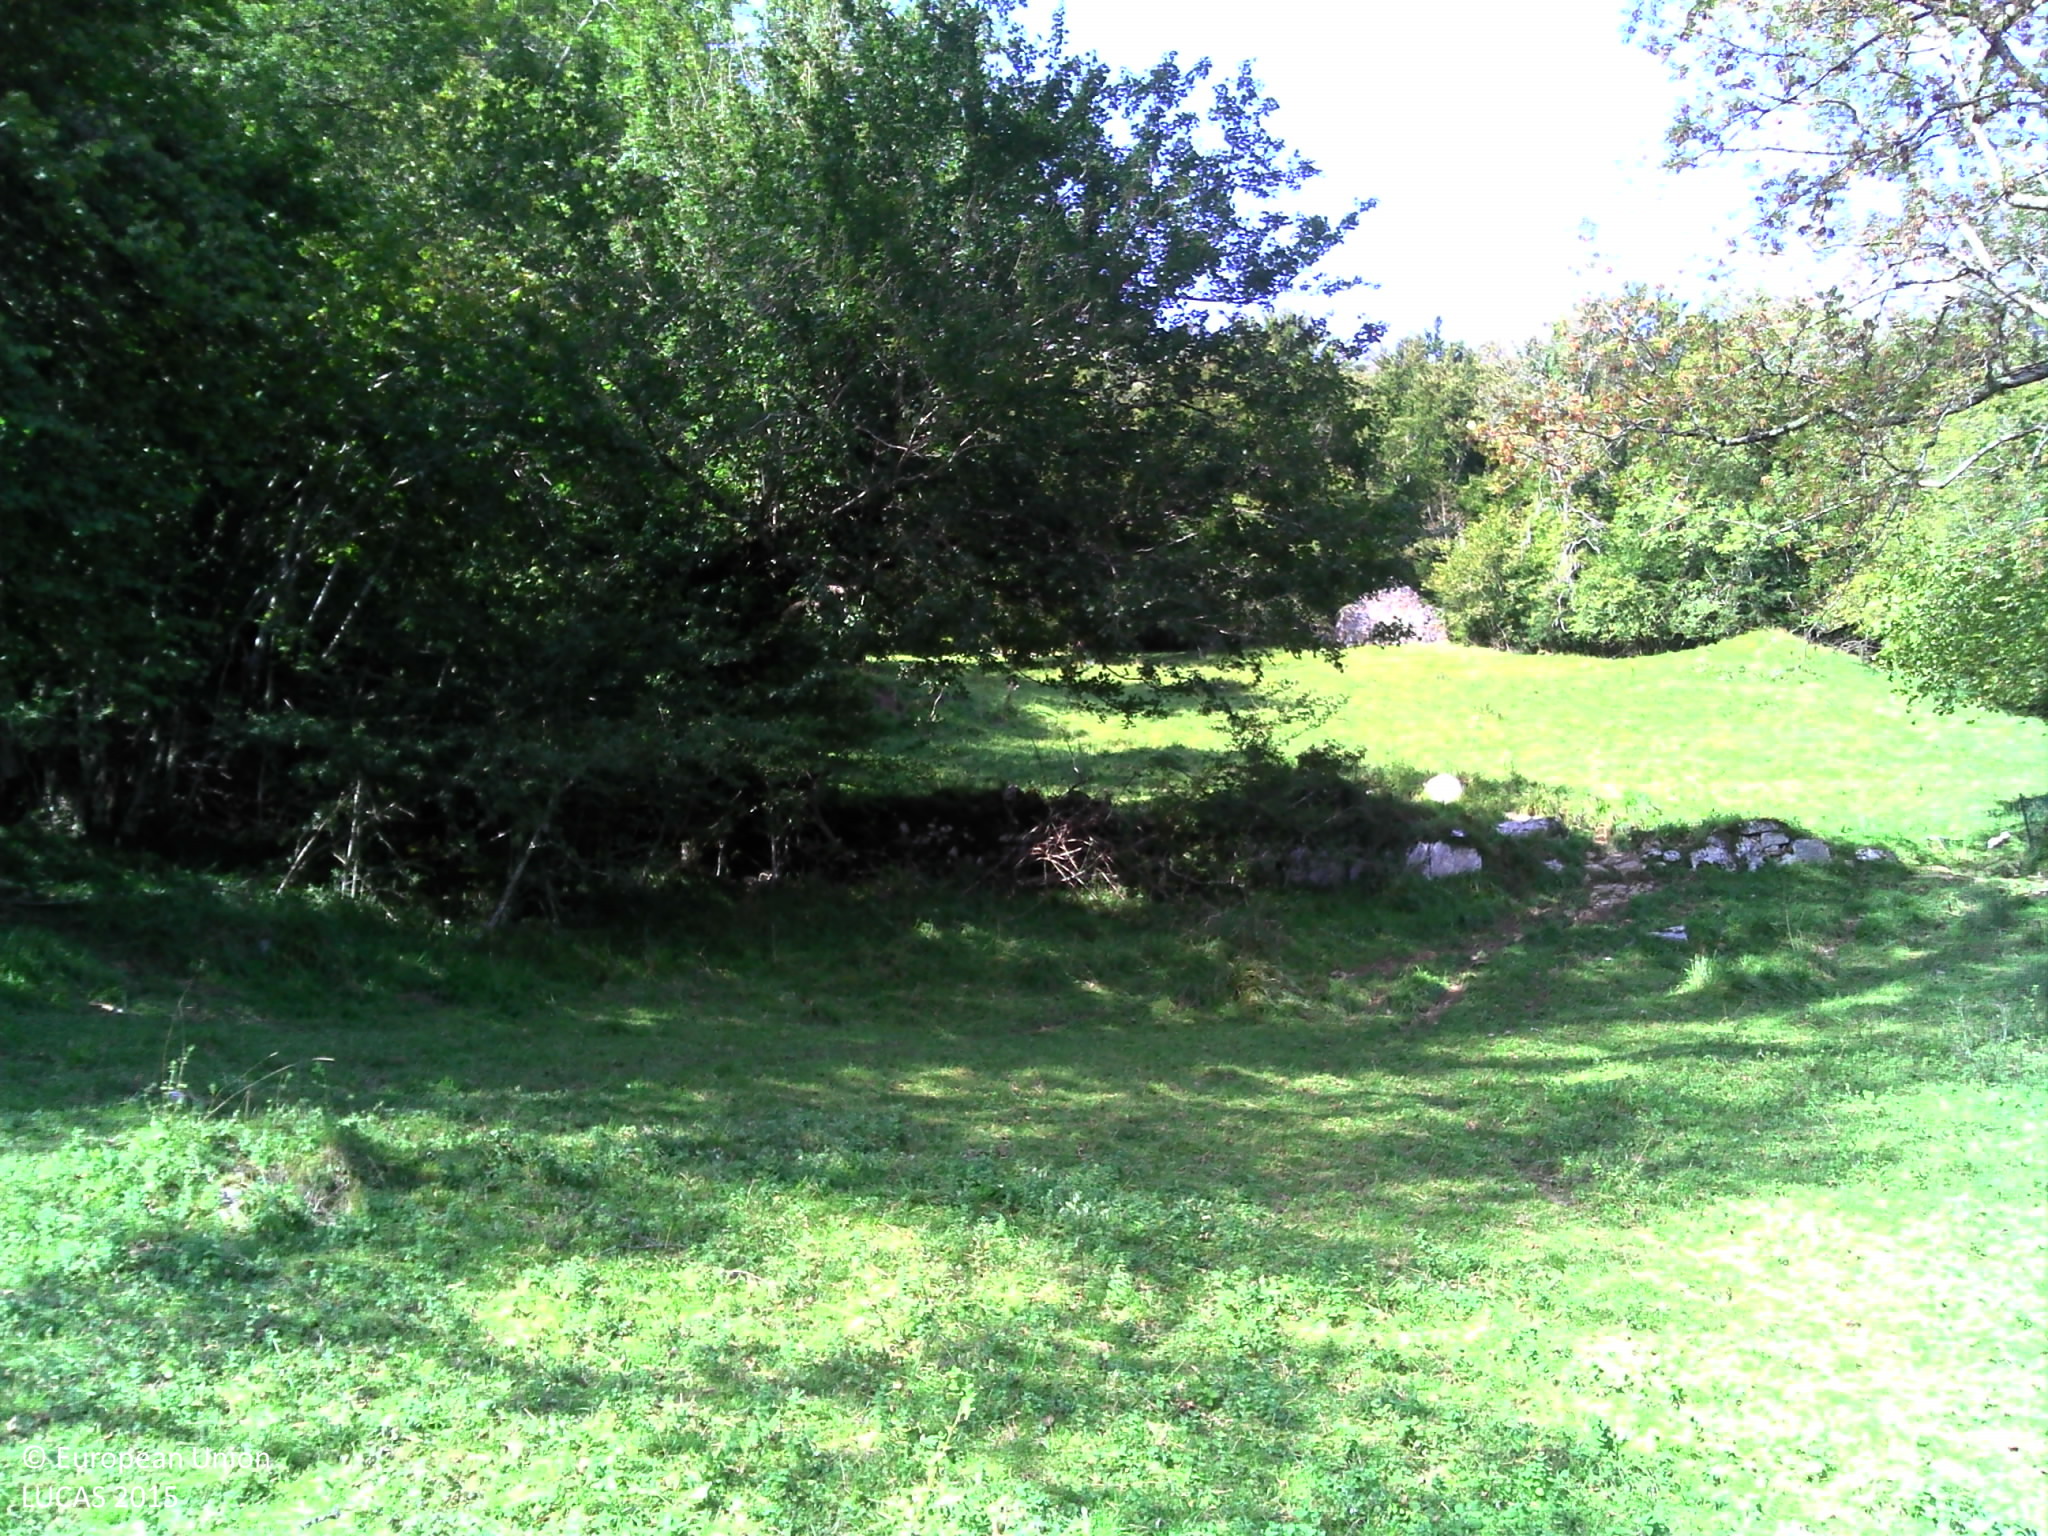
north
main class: Grassland
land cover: Grassland without tree/shrub cover
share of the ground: > 75 %
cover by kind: herbaceous plants 100 %
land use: Agriculture (excluding fallow land and kitchen gardens)
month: September
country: FR
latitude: 43.0577
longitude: -0.6278
